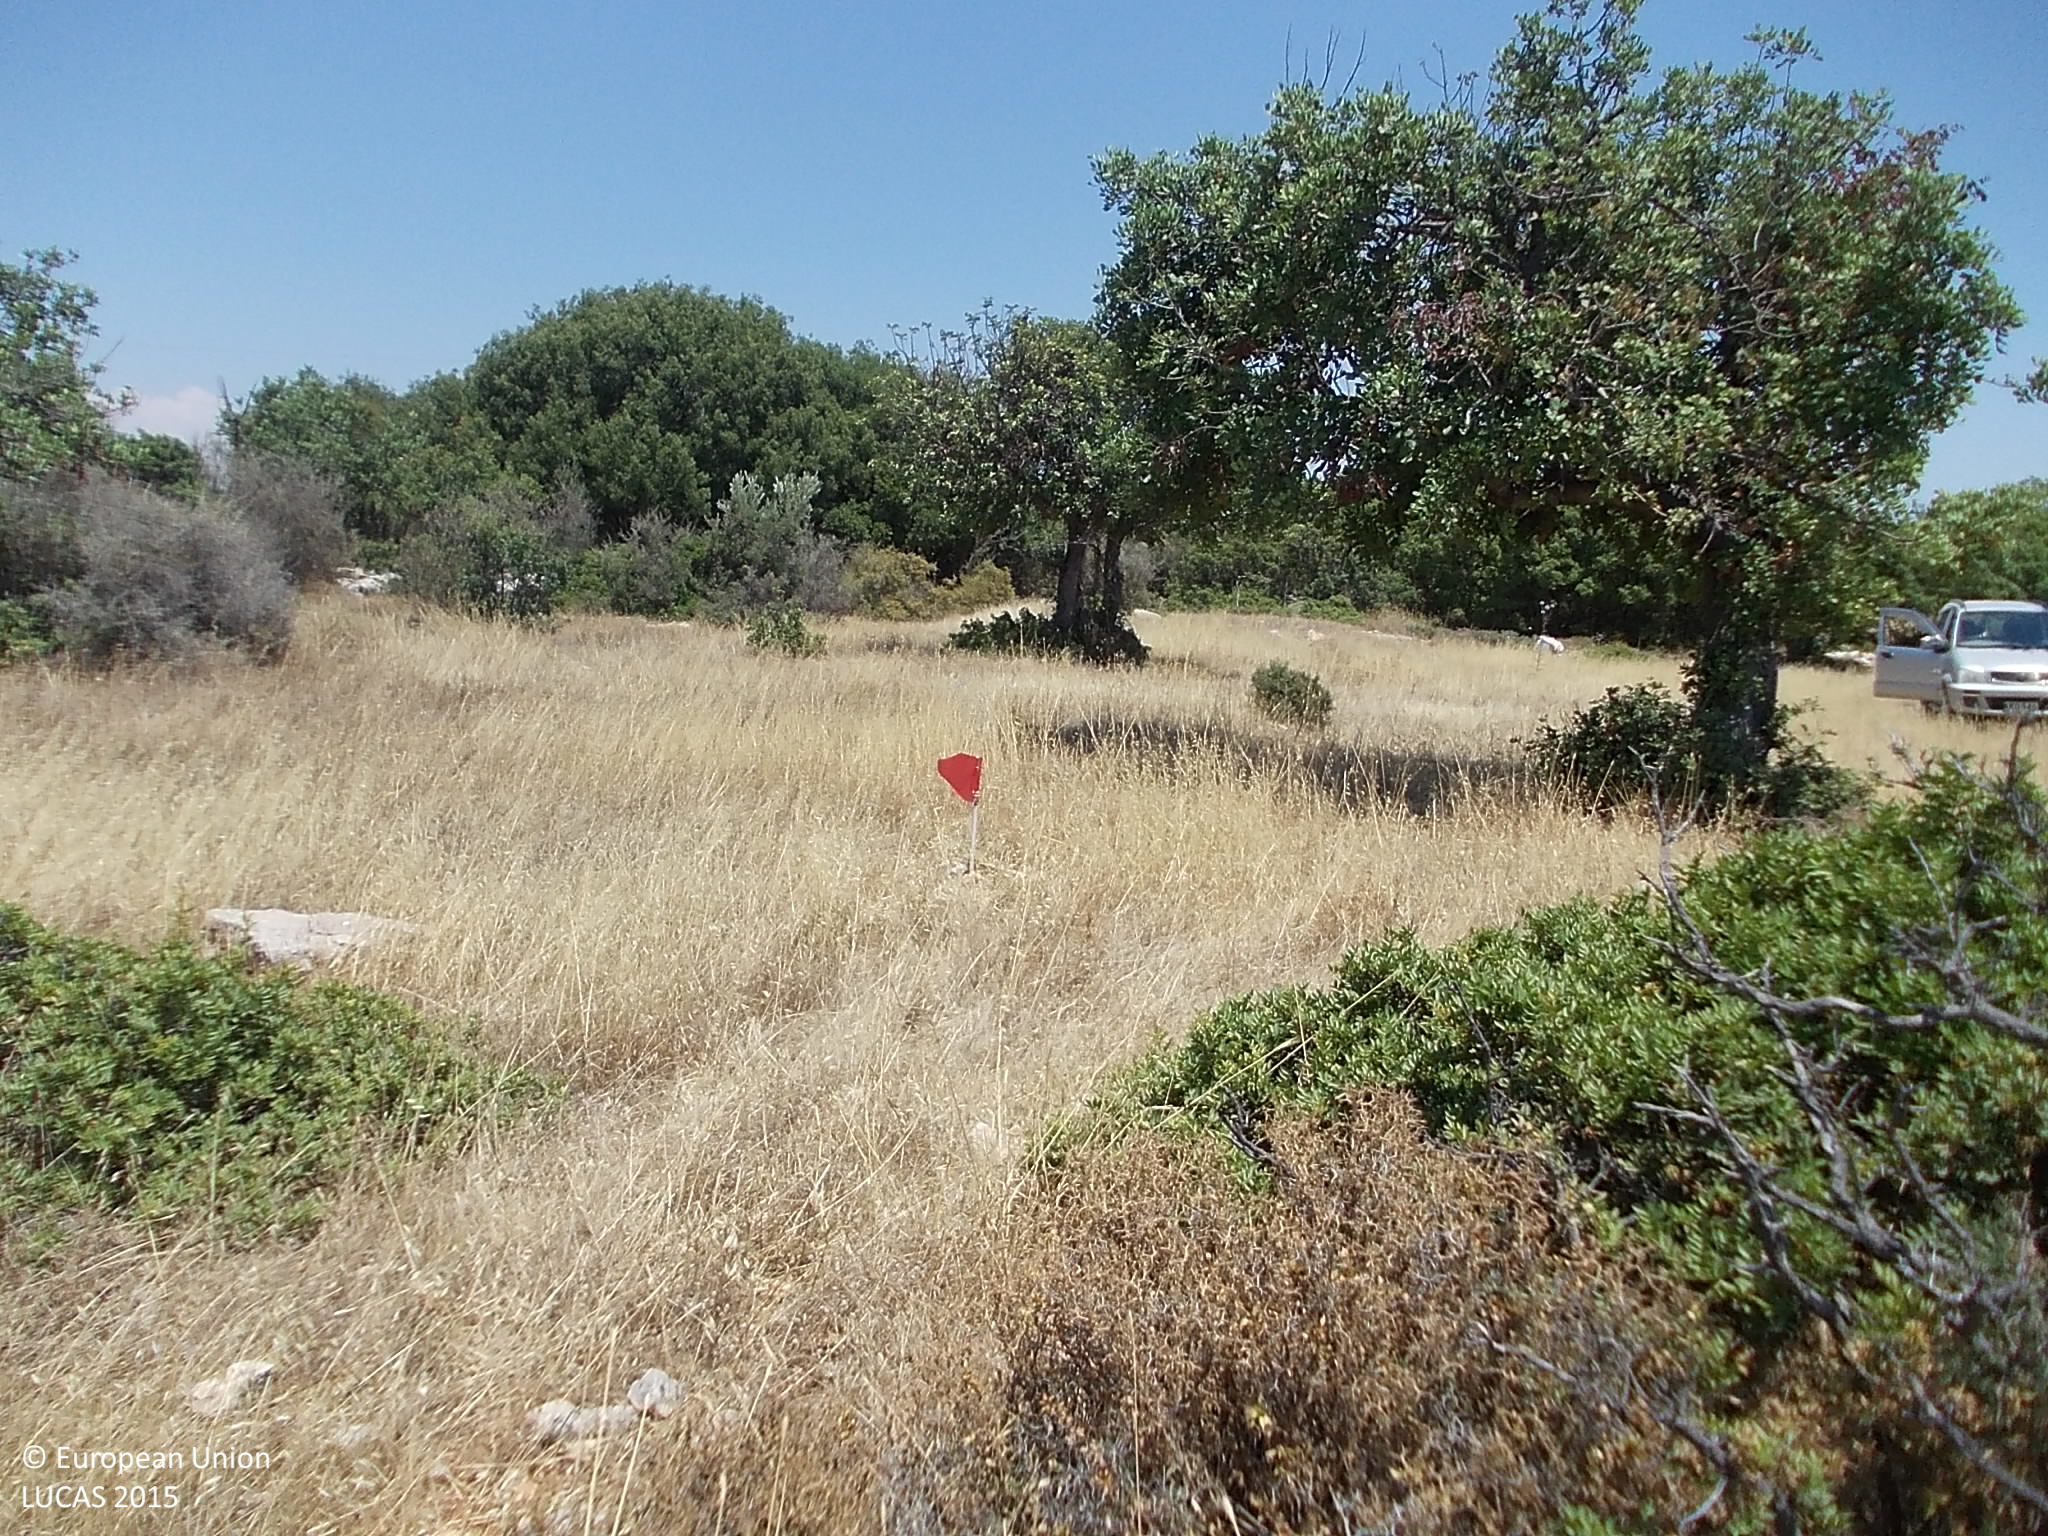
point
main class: Grassland
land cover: Grassland with sparse tree/shrub cover
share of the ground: > 75 %
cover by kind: herbaceous plants 90 %, broadleaved forest trees 5 %, shrubs 5 %
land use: Semi-natural and natural areas not in use
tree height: > 5 m
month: July
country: CY
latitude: 34.7317
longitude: 32.7287
